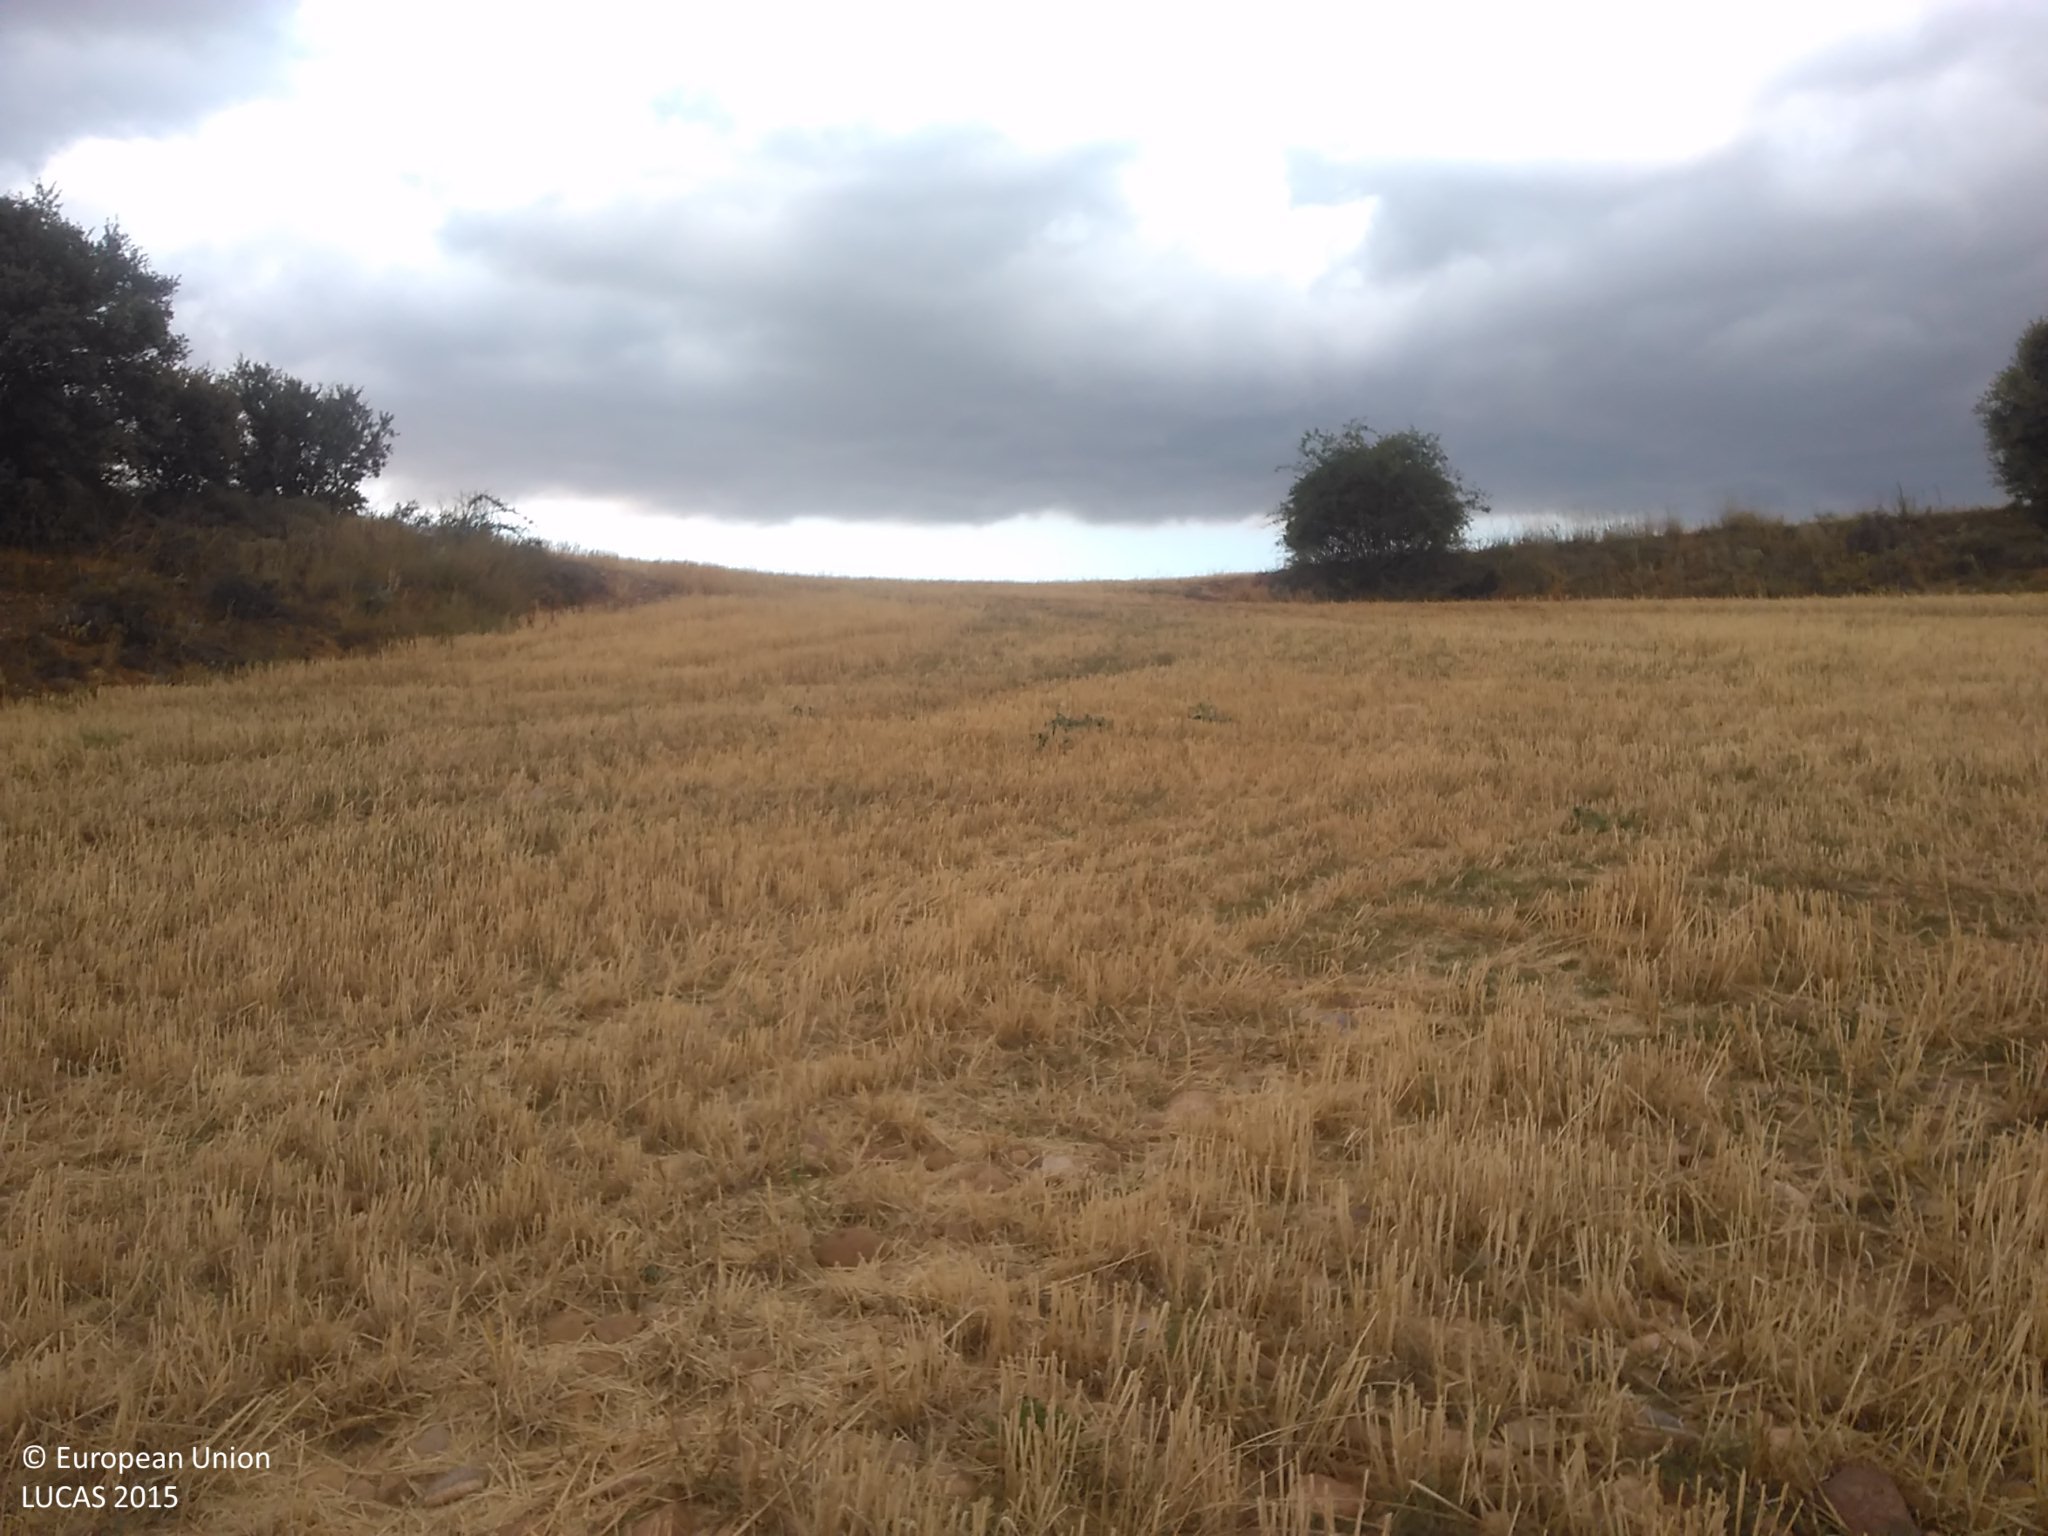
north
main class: Cropland
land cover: Barley
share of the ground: < 10 %
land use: Agriculture (excluding fallow land and kitchen gardens)
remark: Harvested field
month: July
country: ES
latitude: 41.4536
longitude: -2.2305
